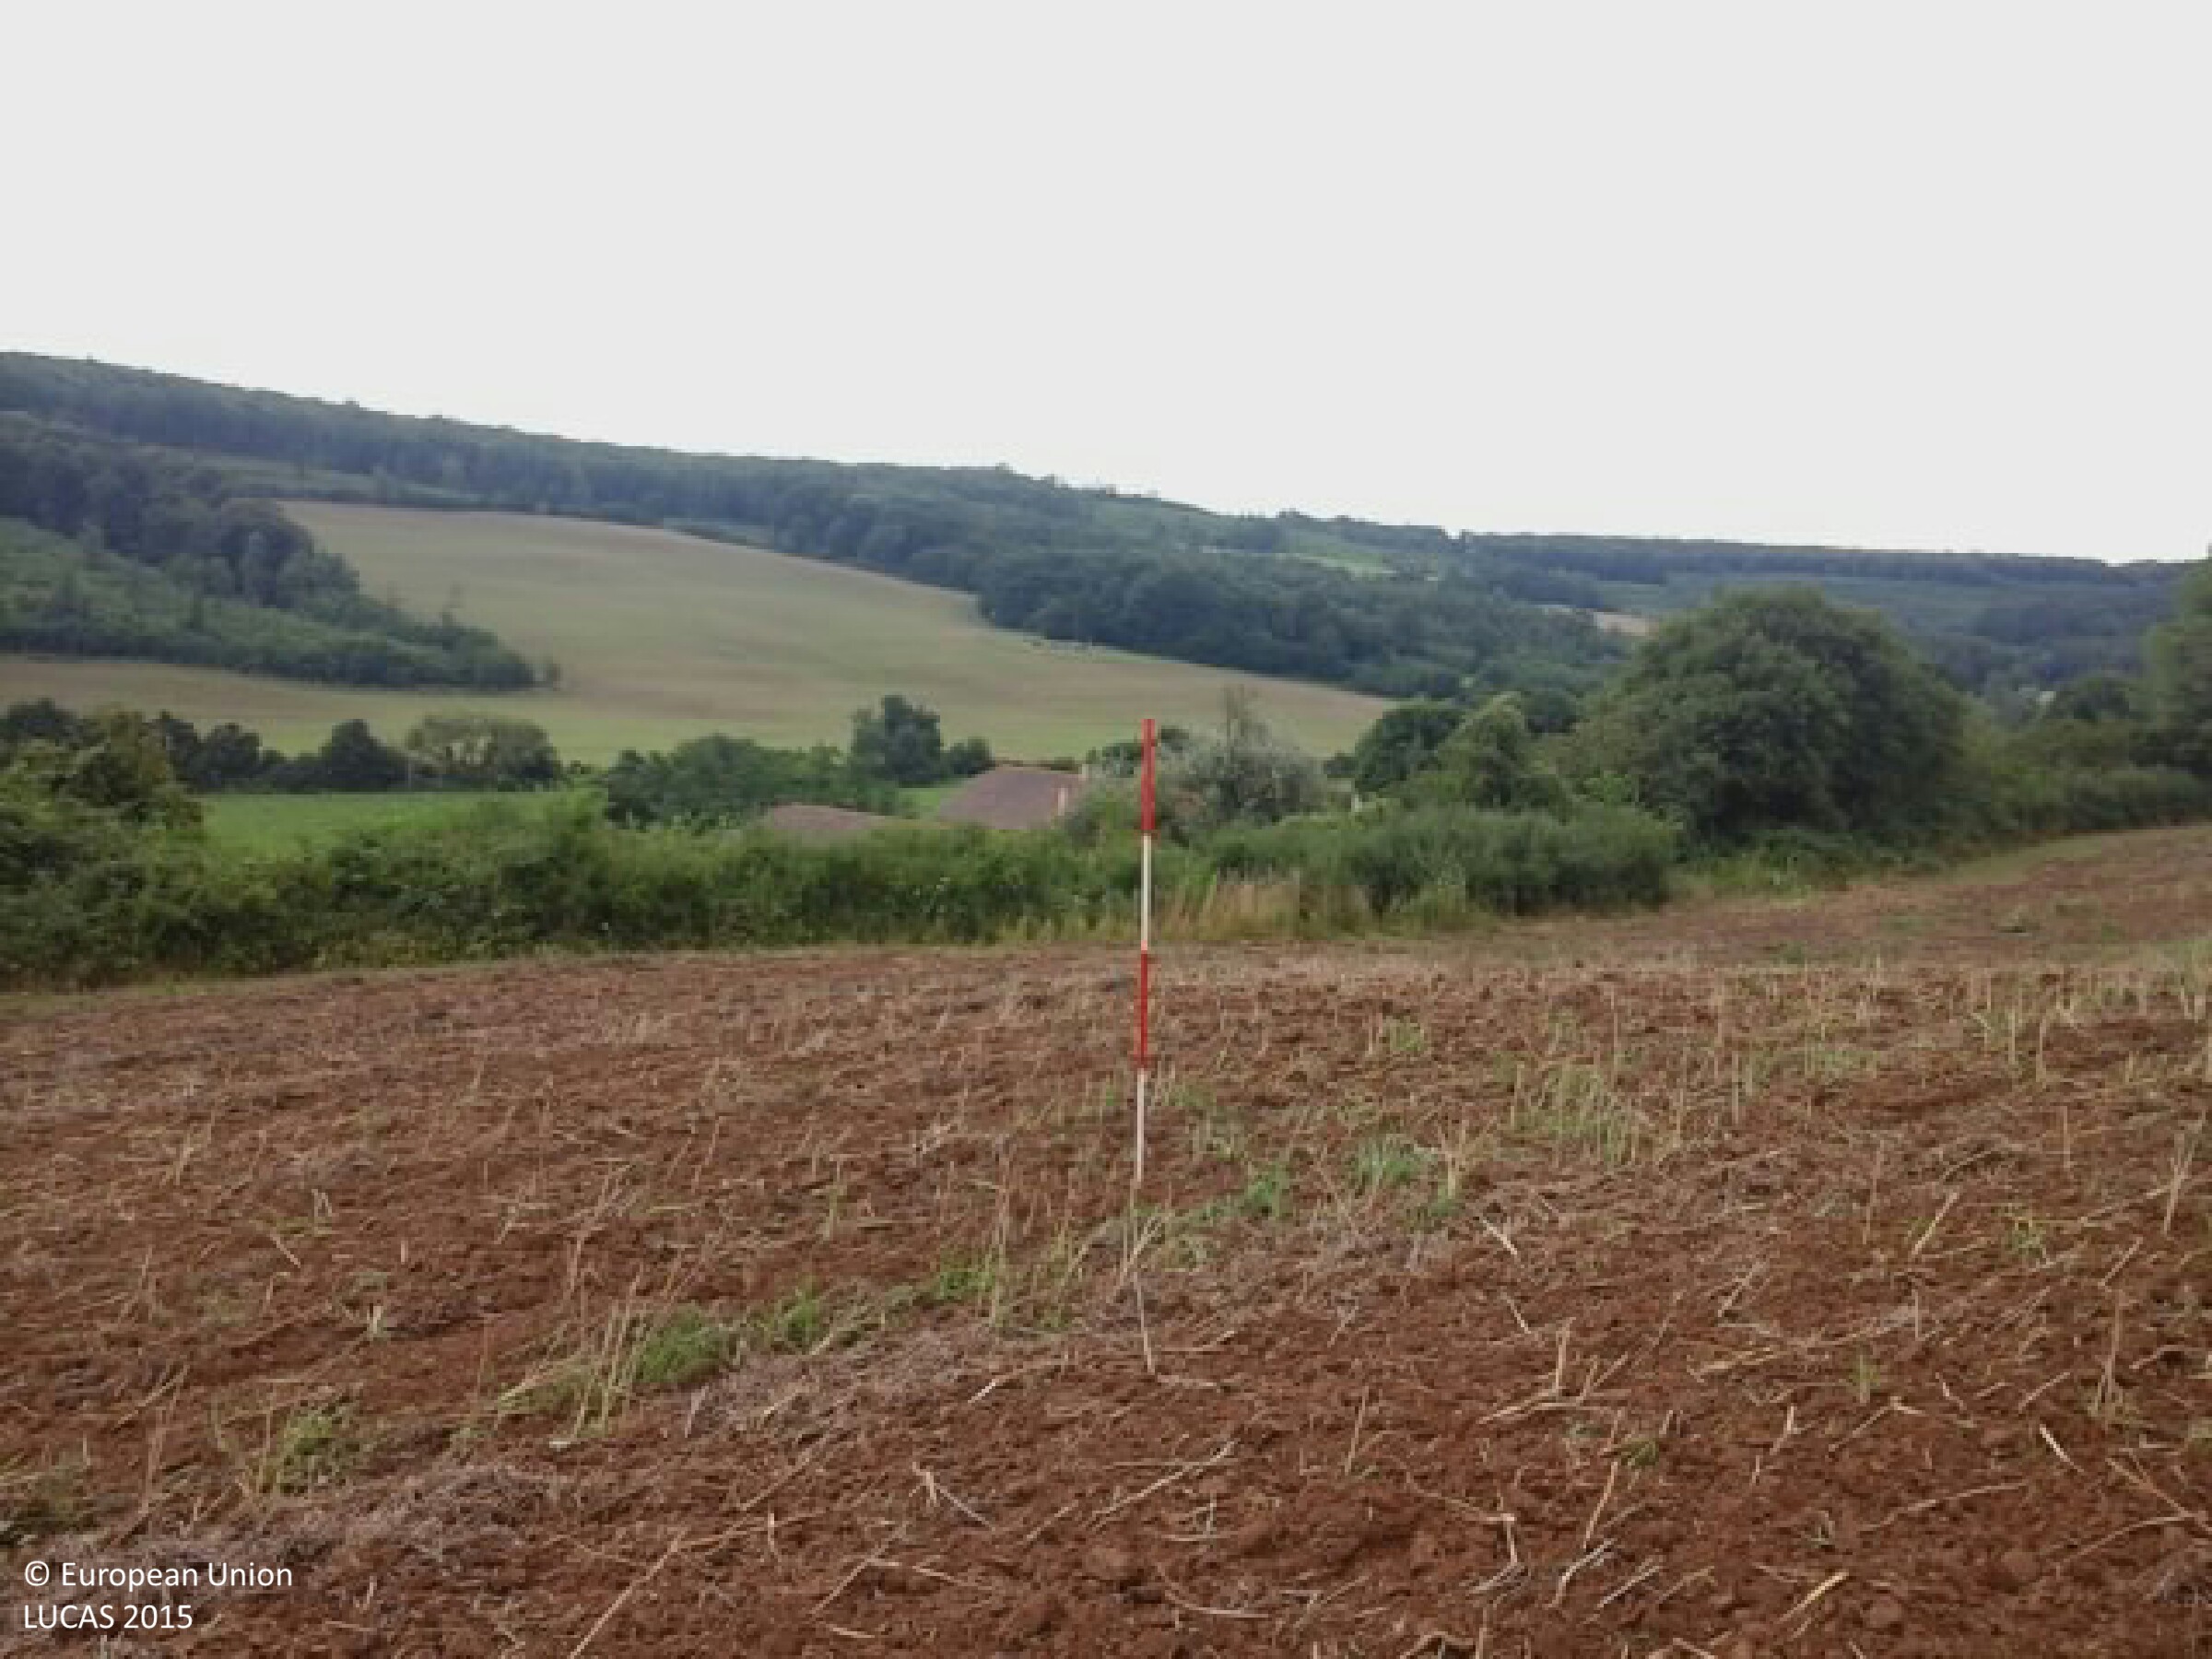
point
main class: Cropland
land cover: Rape and turnip rape
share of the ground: > 75 %
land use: Agriculture (excluding fallow land and kitchen gardens)
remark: Harvested field
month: July
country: HU
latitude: 46.2534
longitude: 17.9580
